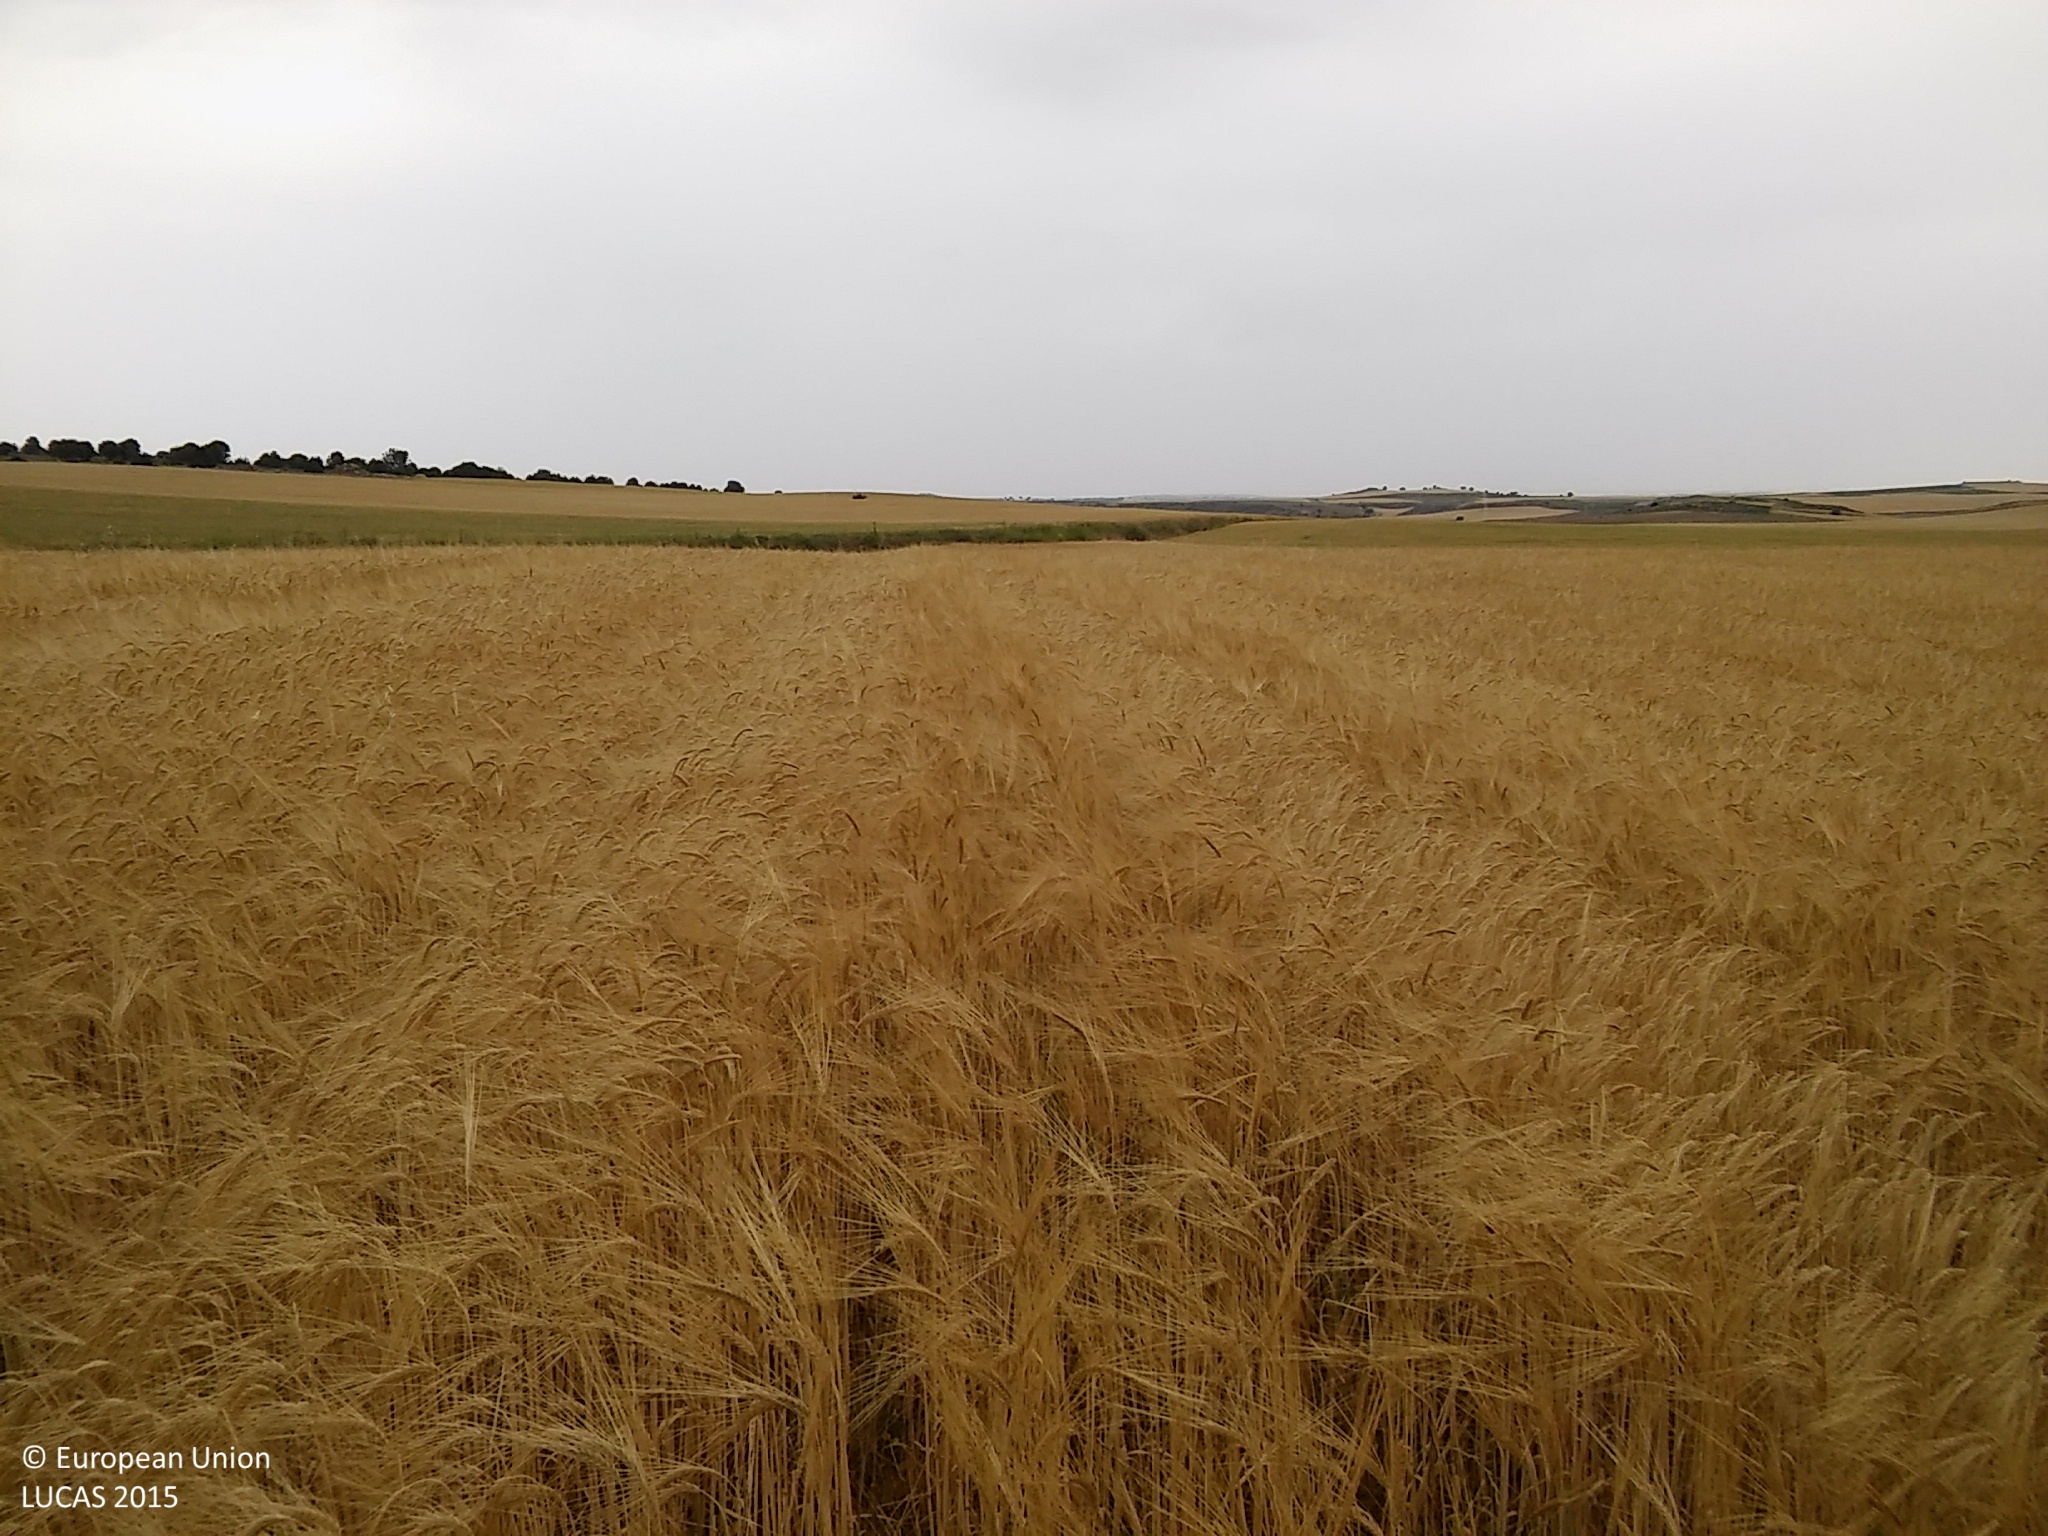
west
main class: Cropland
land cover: Barley
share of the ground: > 75 %
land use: Agriculture (excluding fallow land and kitchen gardens)
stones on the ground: 10 - 25 %
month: June
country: ES
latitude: 41.5655
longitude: -3.6129
